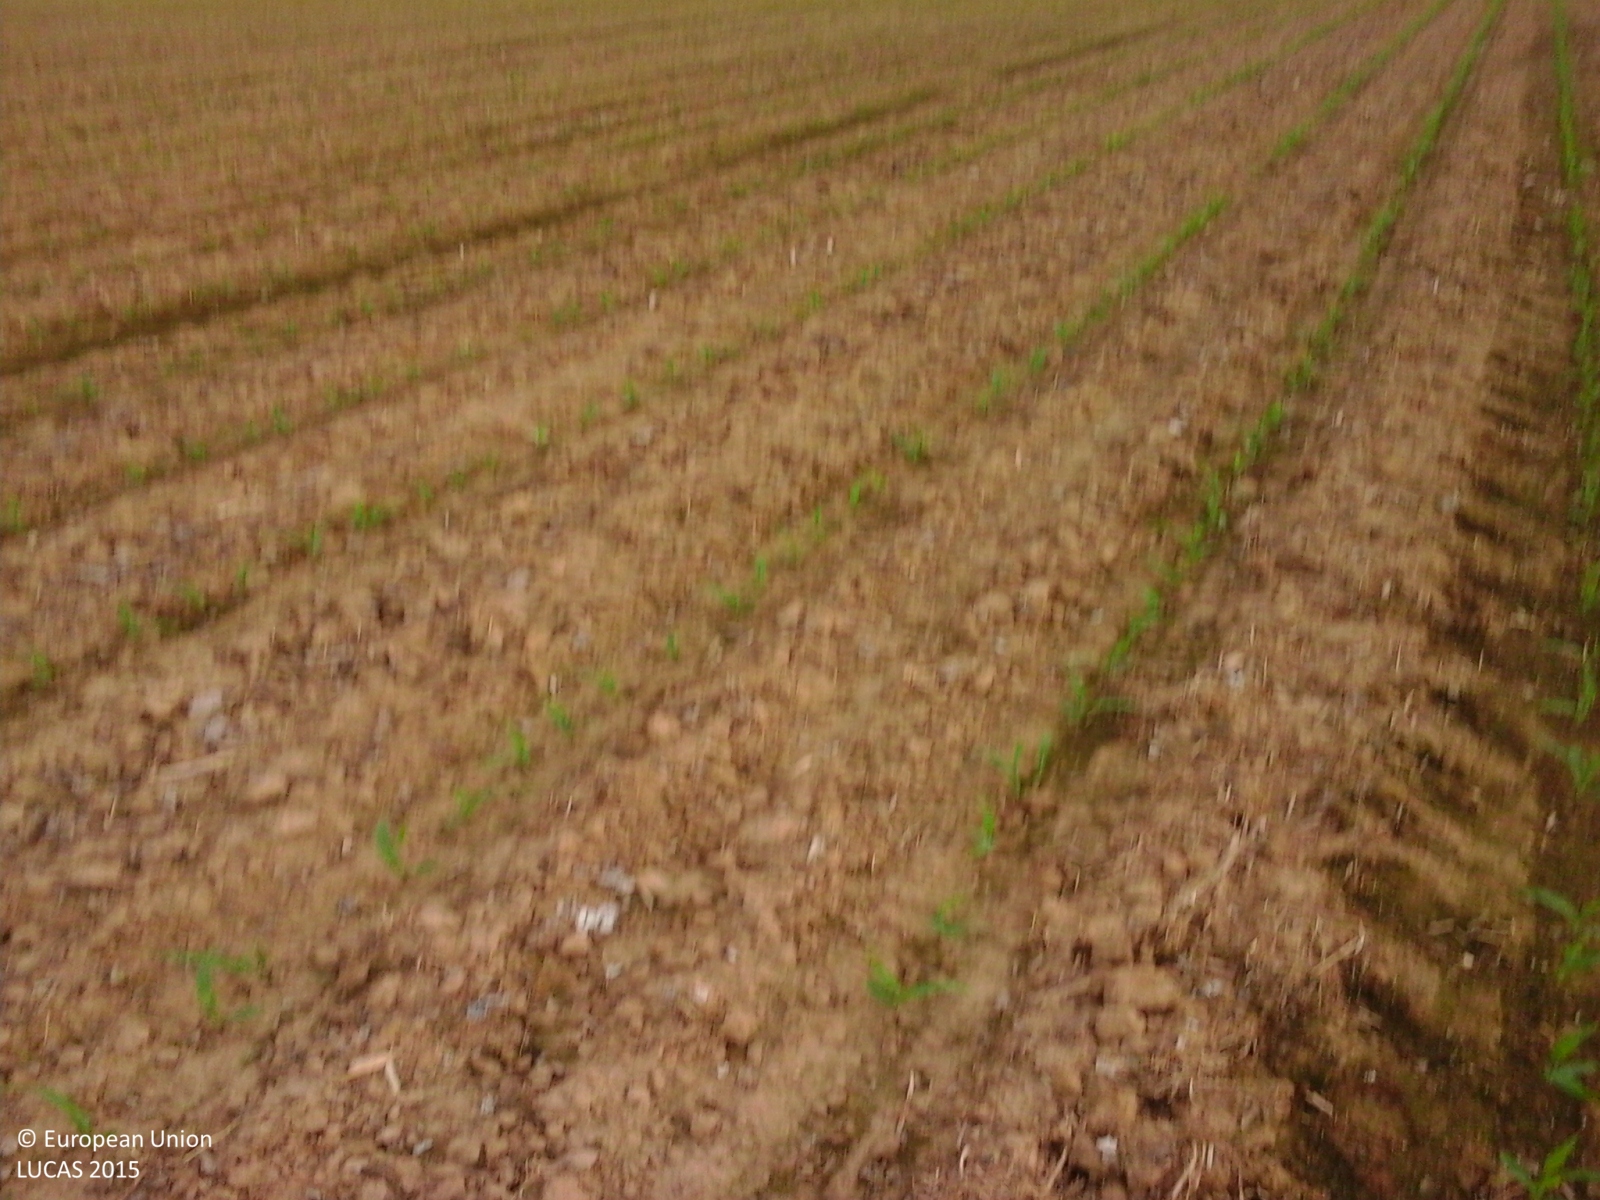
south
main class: Cropland
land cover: Maize
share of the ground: < 10 %
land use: Agriculture (excluding fallow land and kitchen gardens)
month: May
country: IT
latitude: 45.2340
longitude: 9.8601
